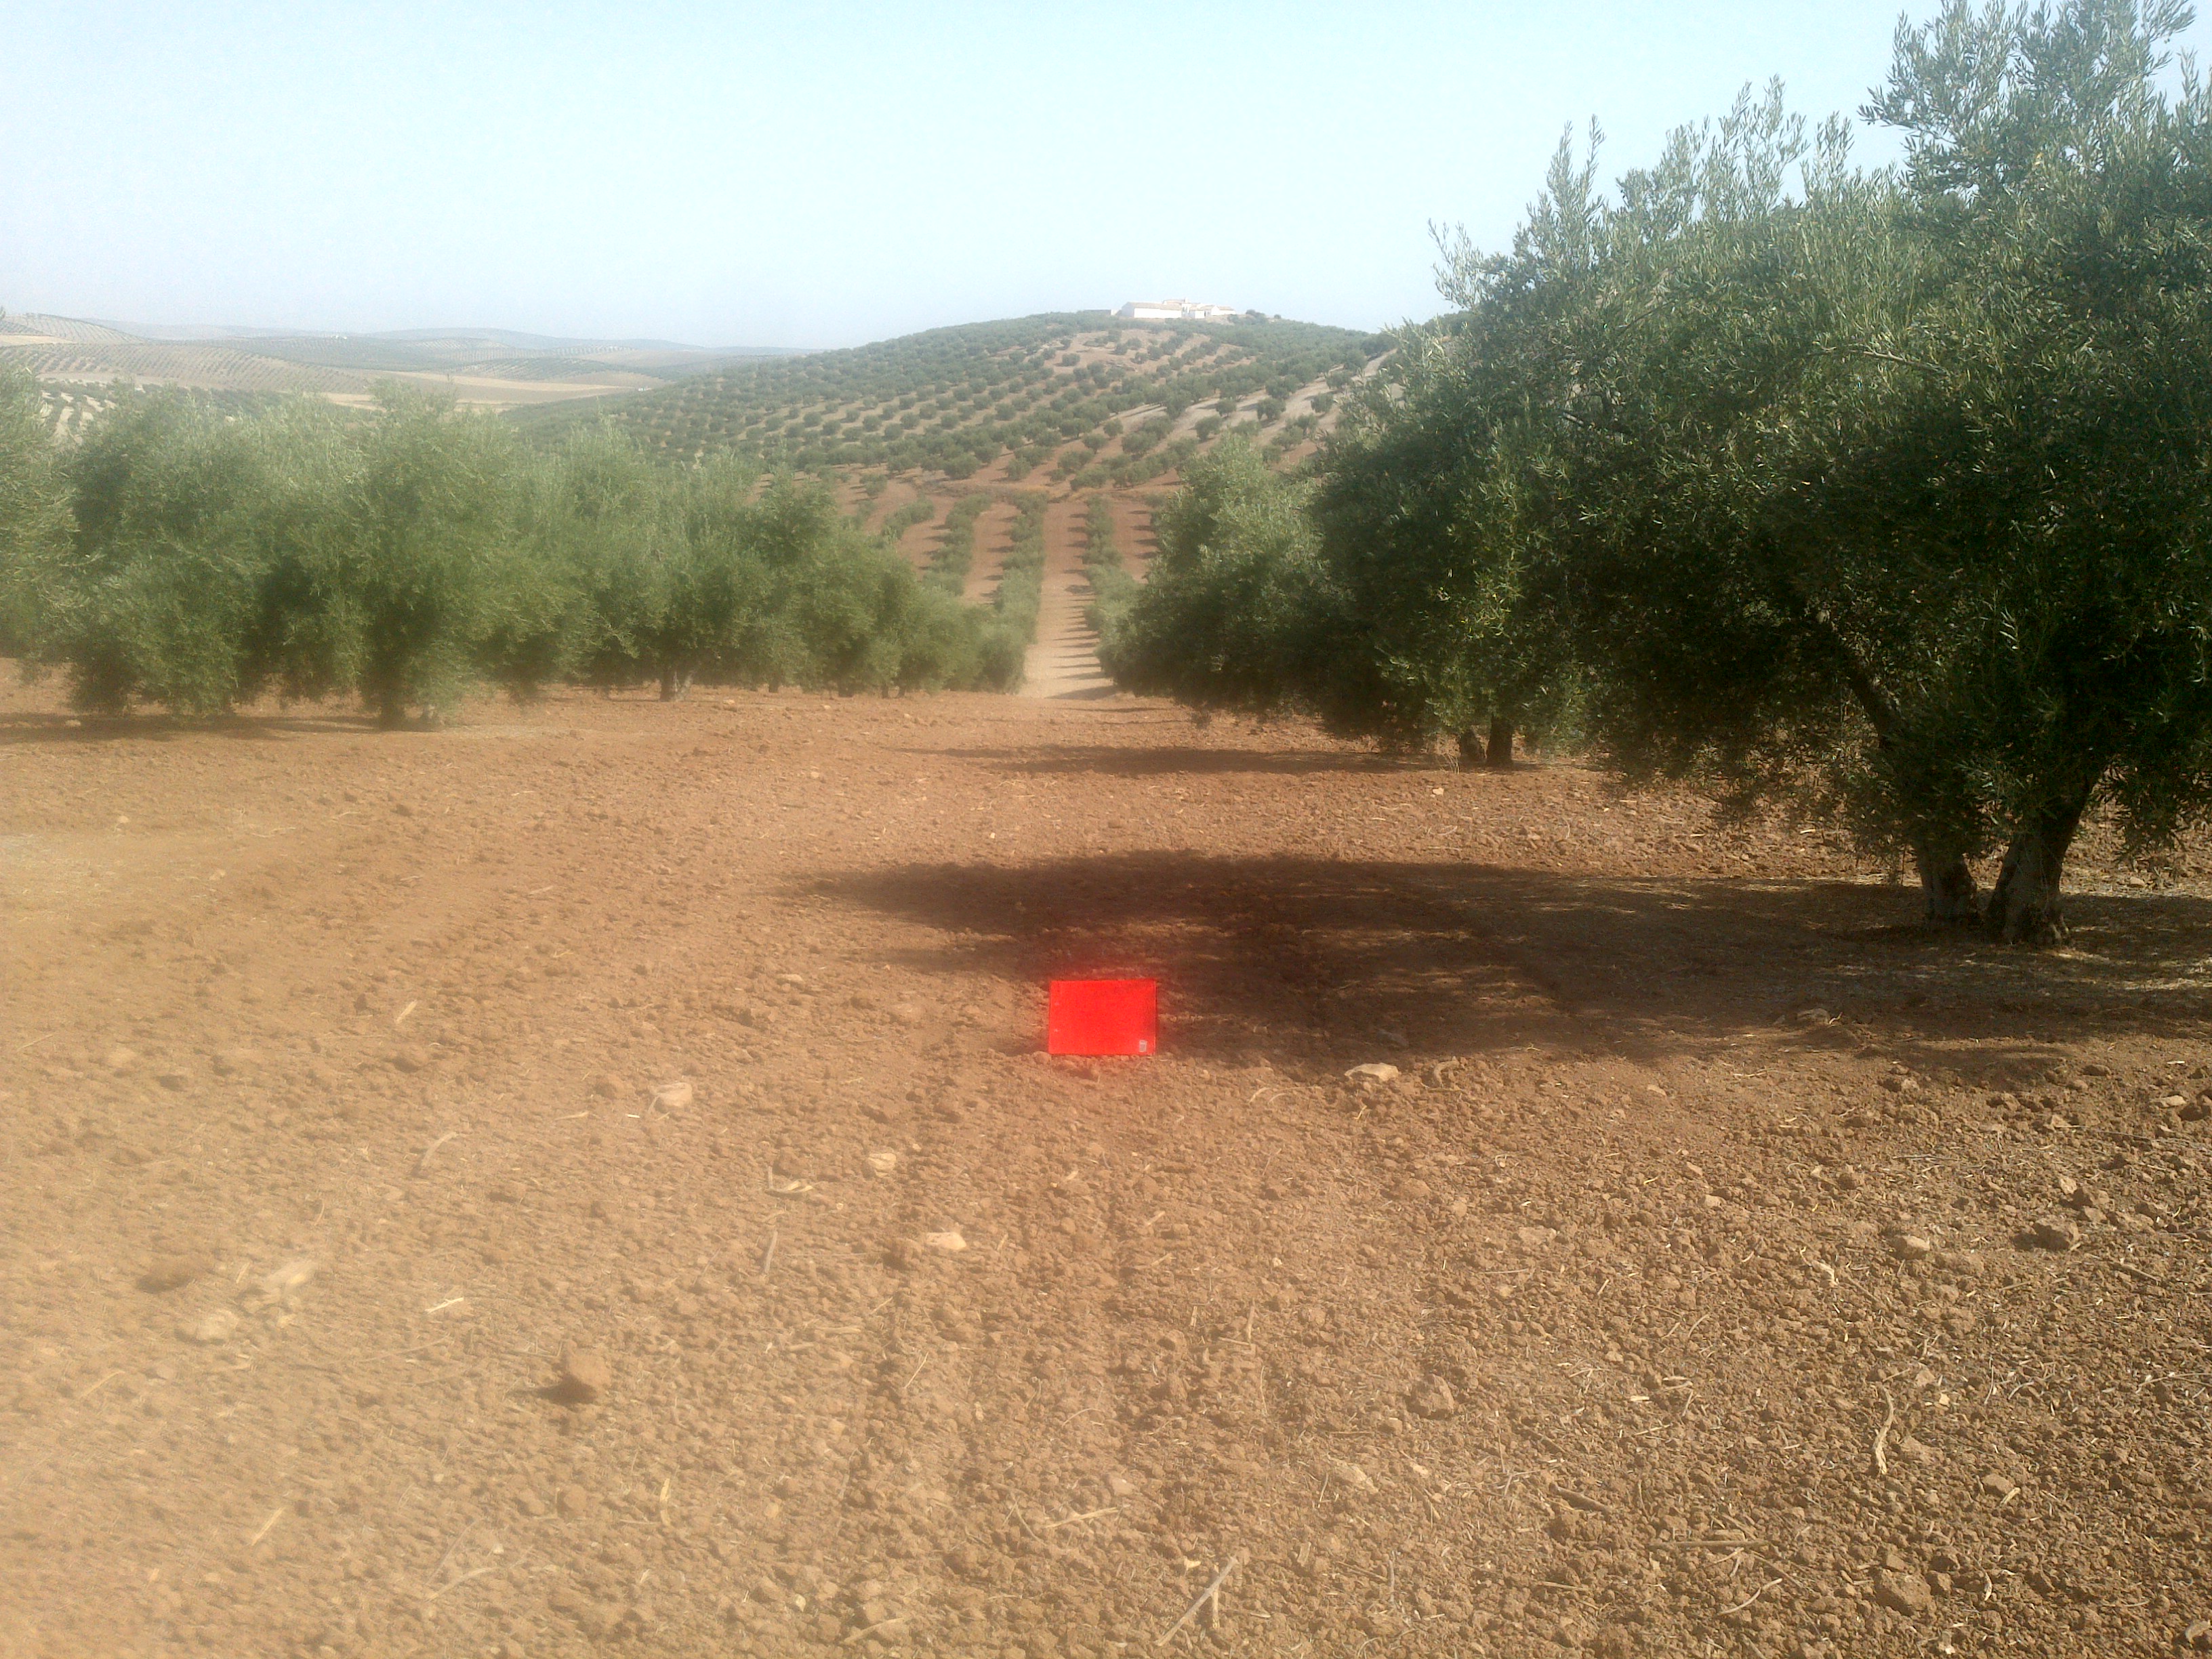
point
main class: Cropland
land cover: Olive groves
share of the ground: 50 - 75 %
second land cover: Other bare soil
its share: > 75 %
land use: Agriculture (excluding fallow land and kitchen gardens)
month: June
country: ES
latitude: 37.6994
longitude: -4.2384
